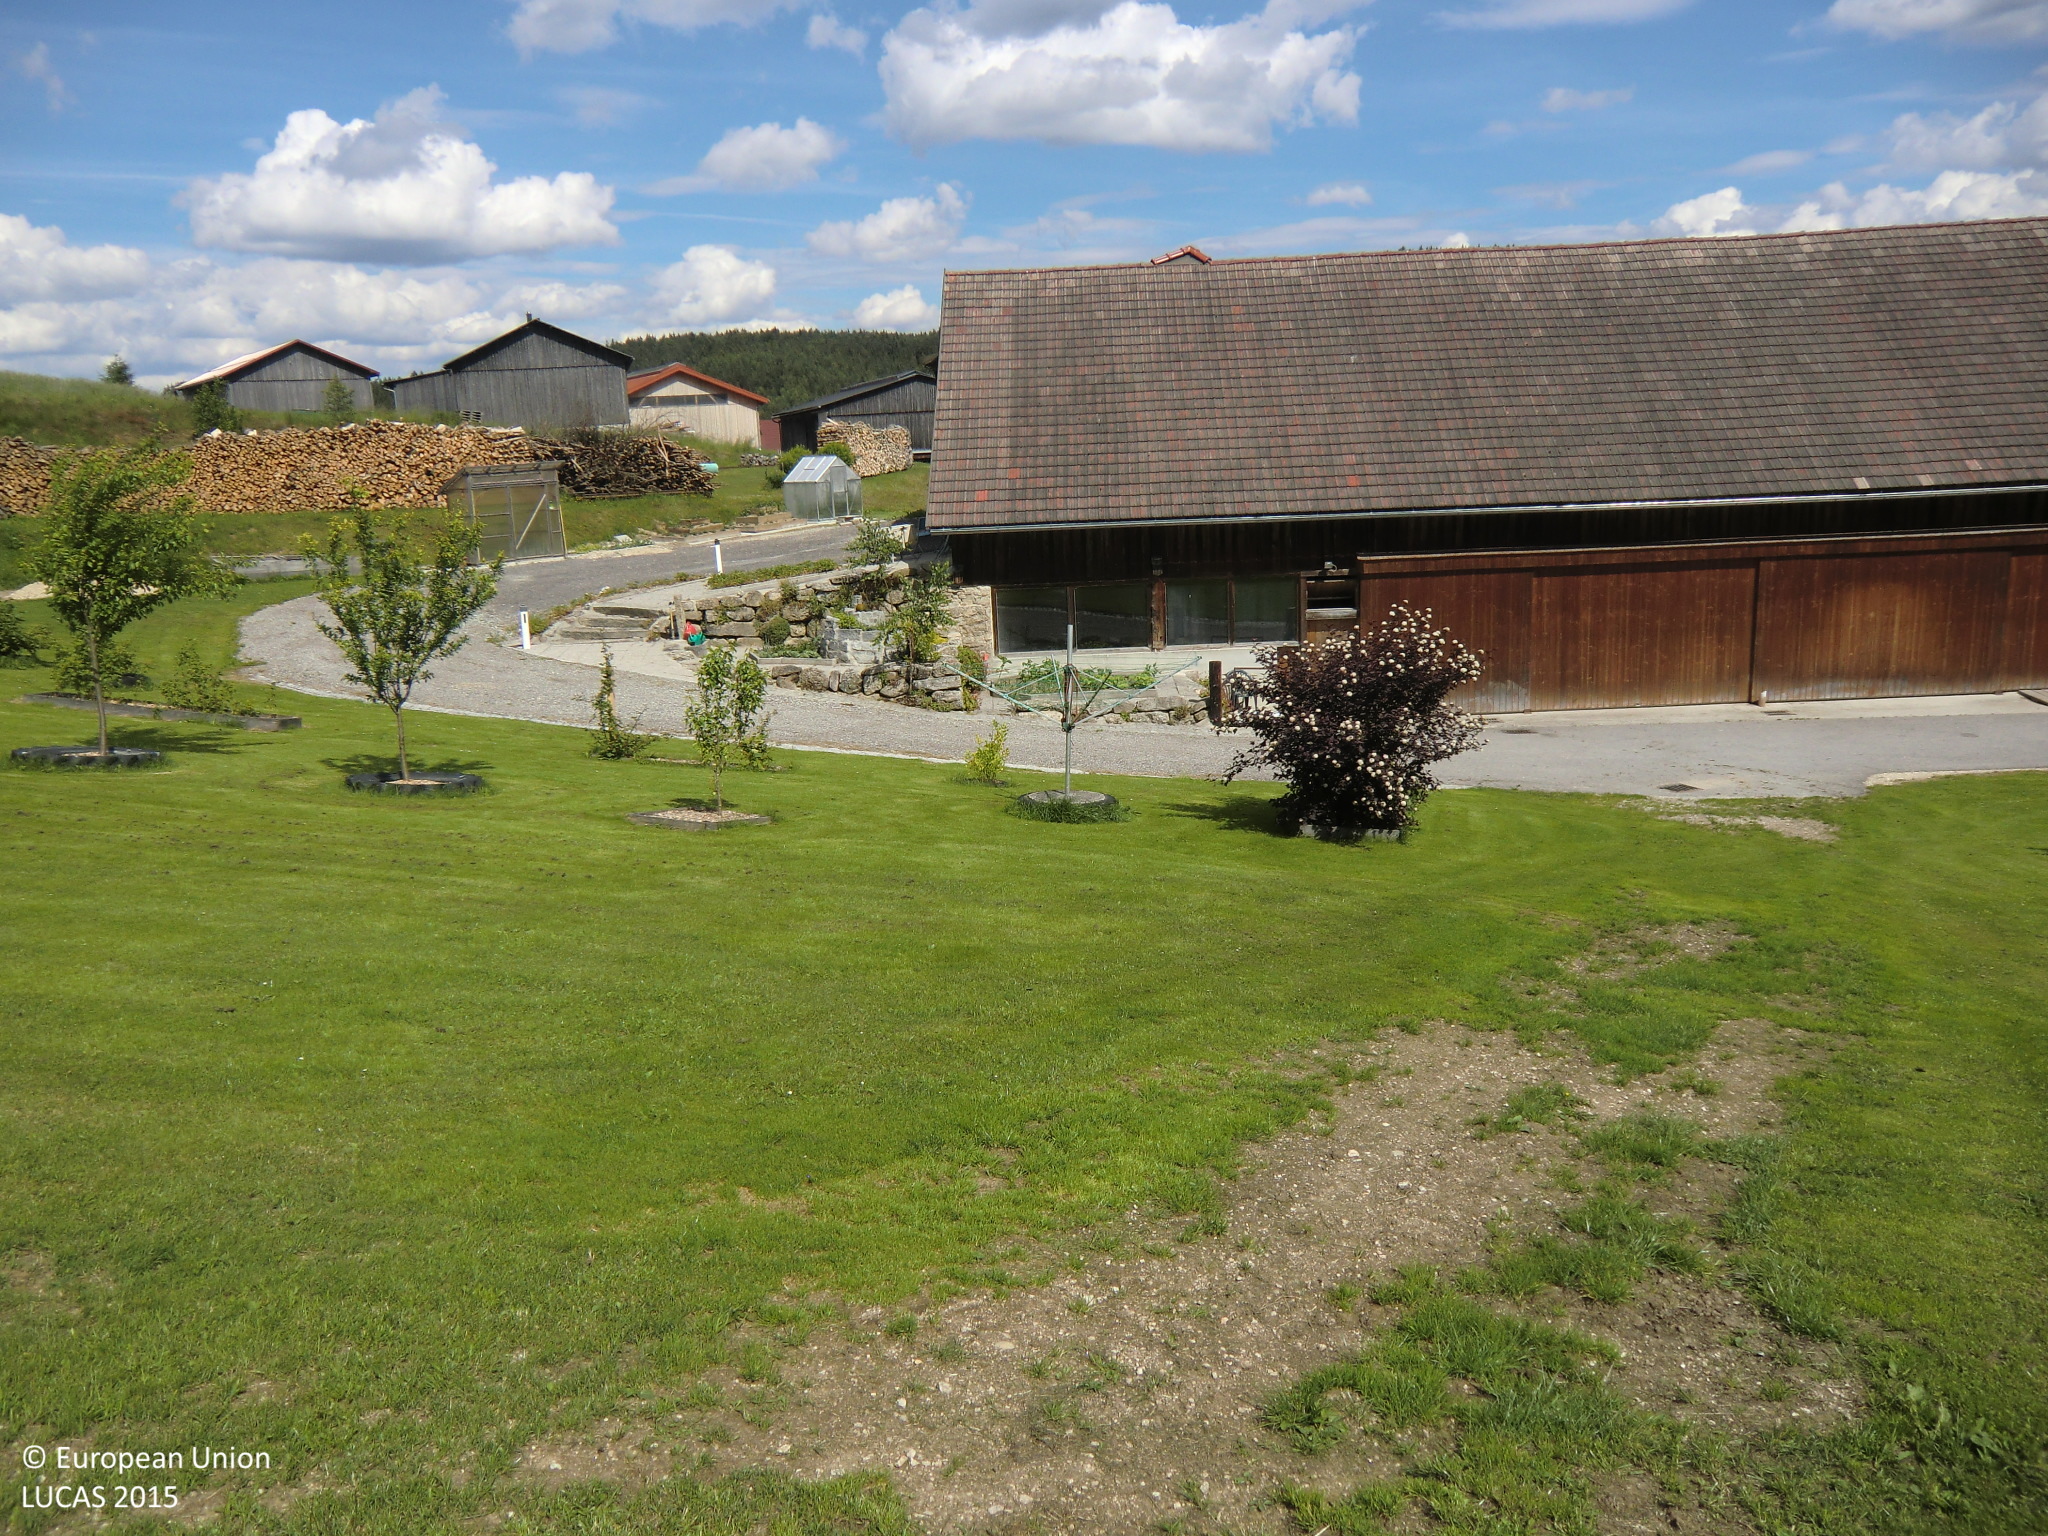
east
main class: Grassland
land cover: Grassland without tree/shrub cover
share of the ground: > 75 %
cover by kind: herbaceous plants 95 %, unconsolidated bare surface 5 %
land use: Agriculture (excluding fallow land and kitchen gardens)
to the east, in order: Grassland without tree/shrub cover; Artificial constructions in urban areas
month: June
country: AT
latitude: 48.5668
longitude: 14.8664
